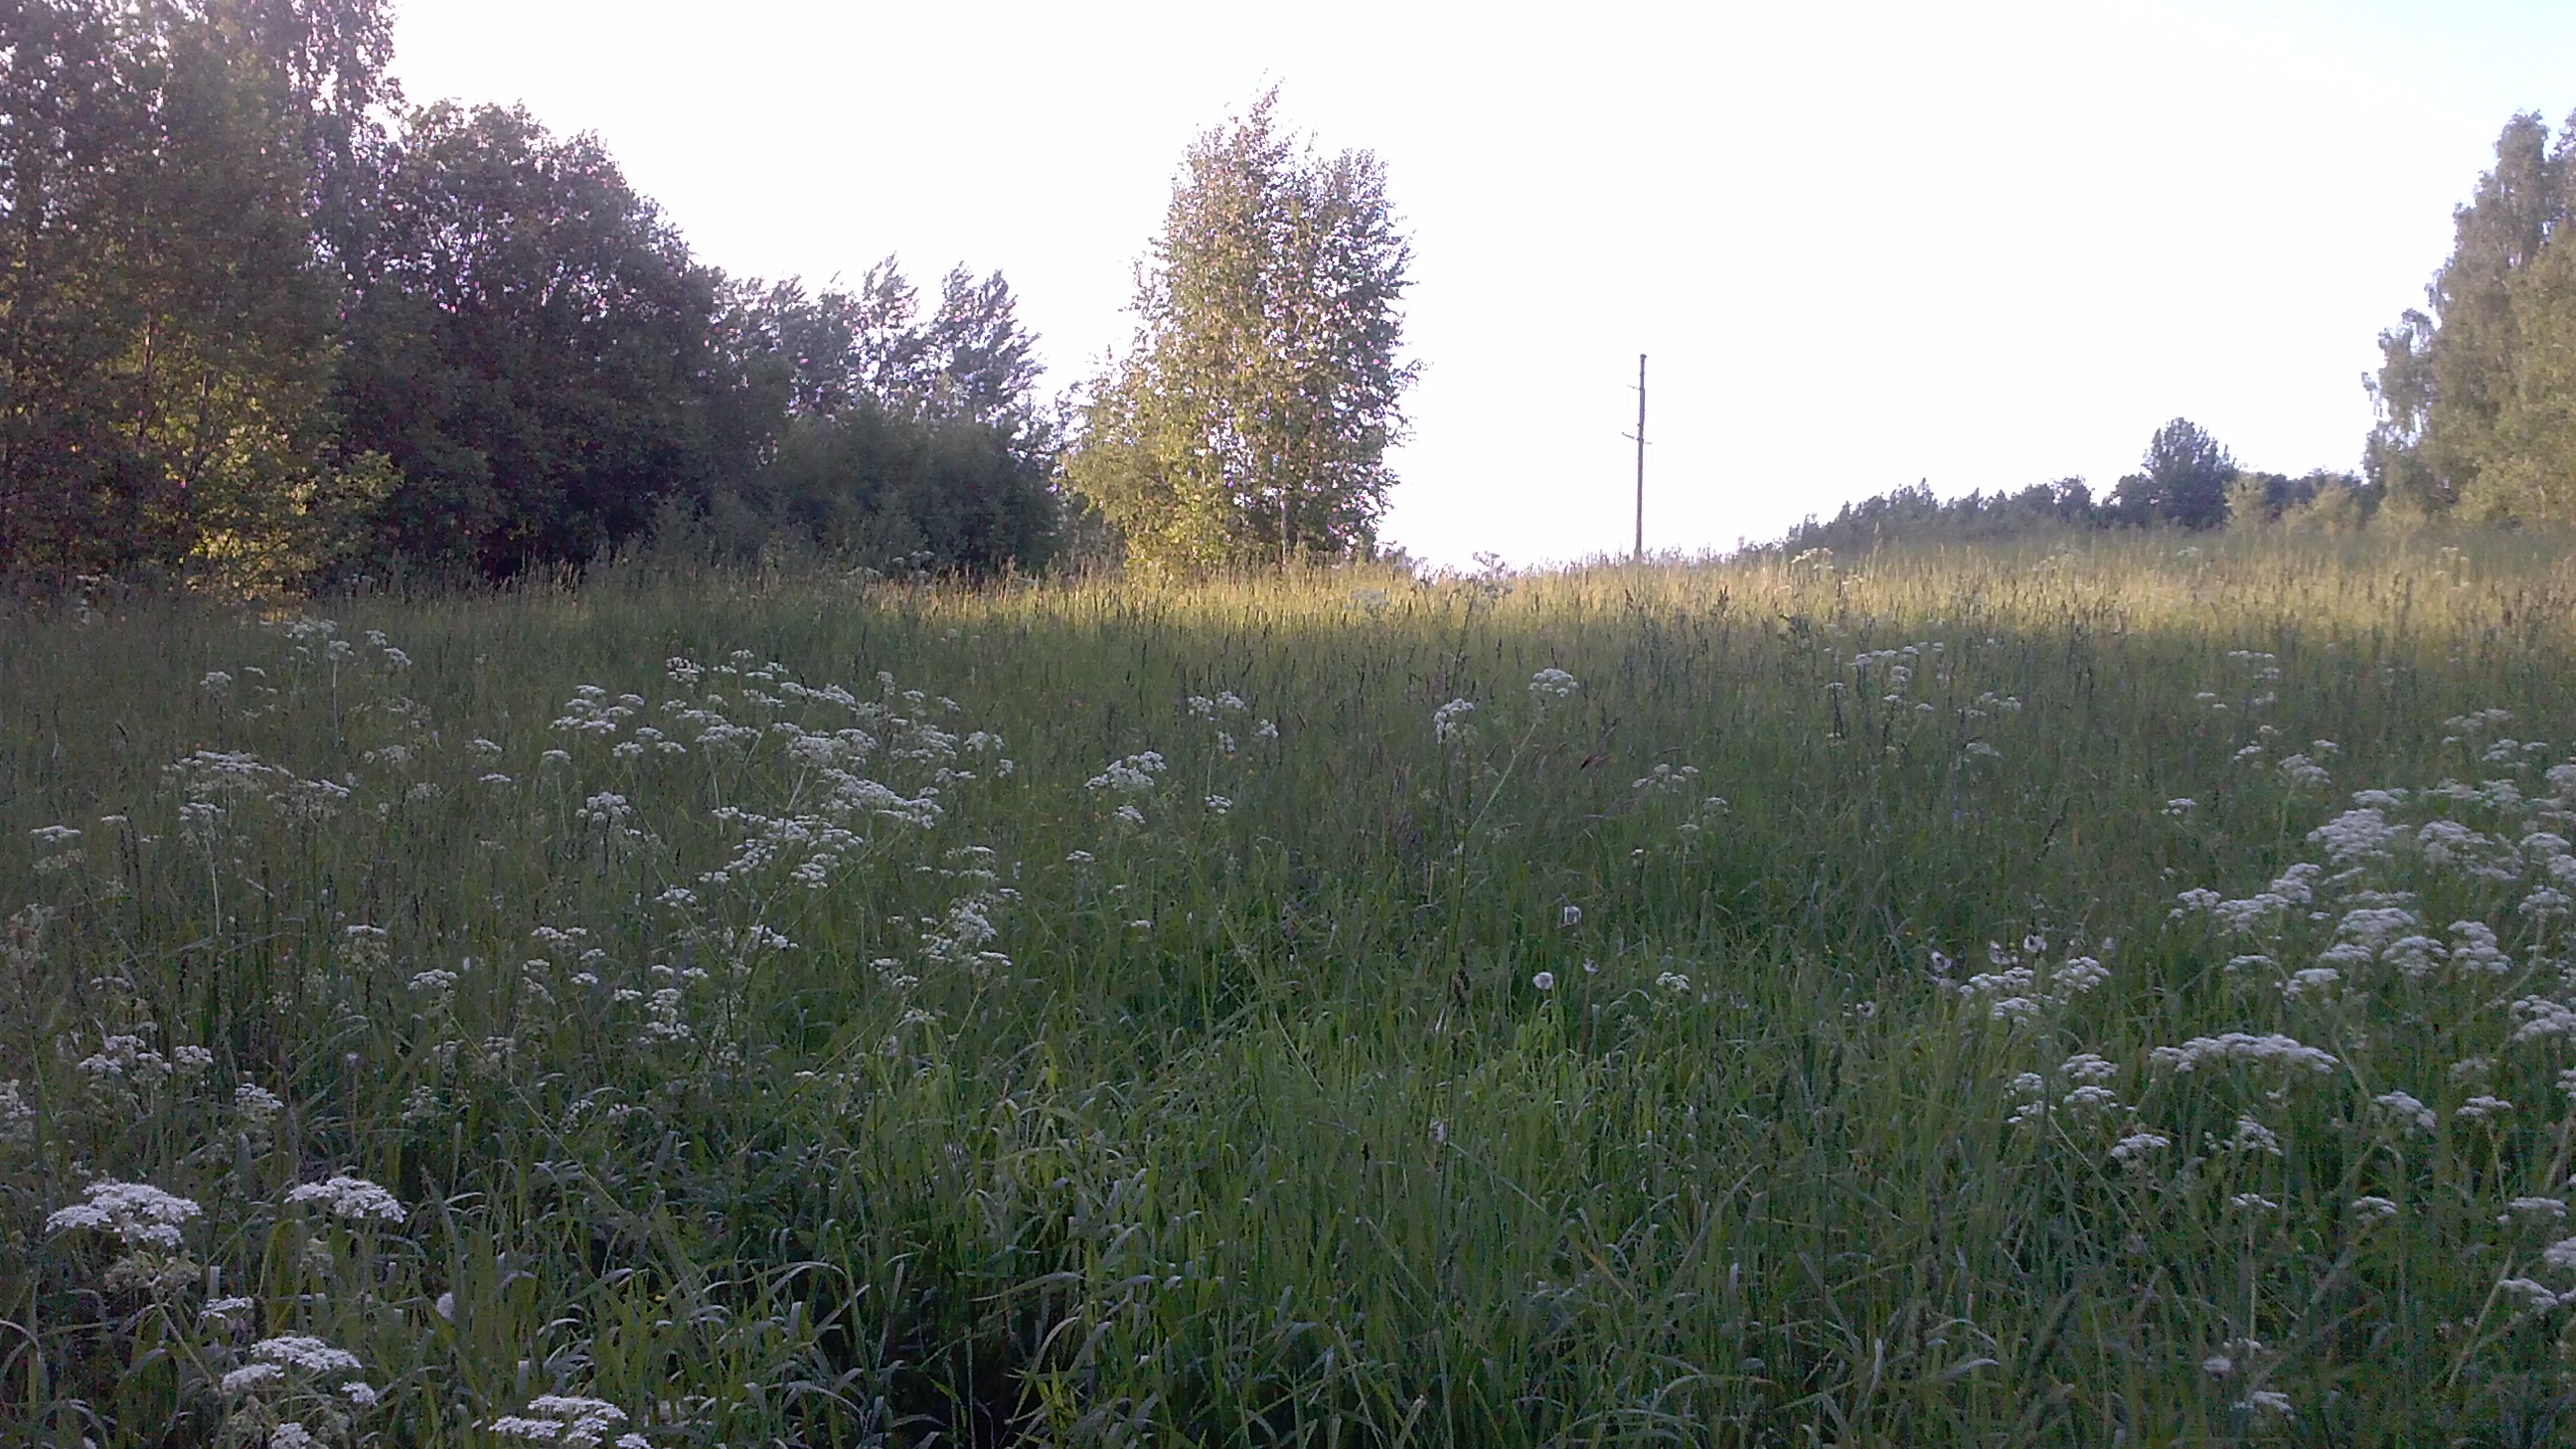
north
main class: Grassland
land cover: Spontaneously vegetated surfaces
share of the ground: > 75 %
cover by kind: herbaceous plants 100 %
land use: Fallow land
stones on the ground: < 10 %
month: June
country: LV
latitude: 56.4305
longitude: 27.8840
